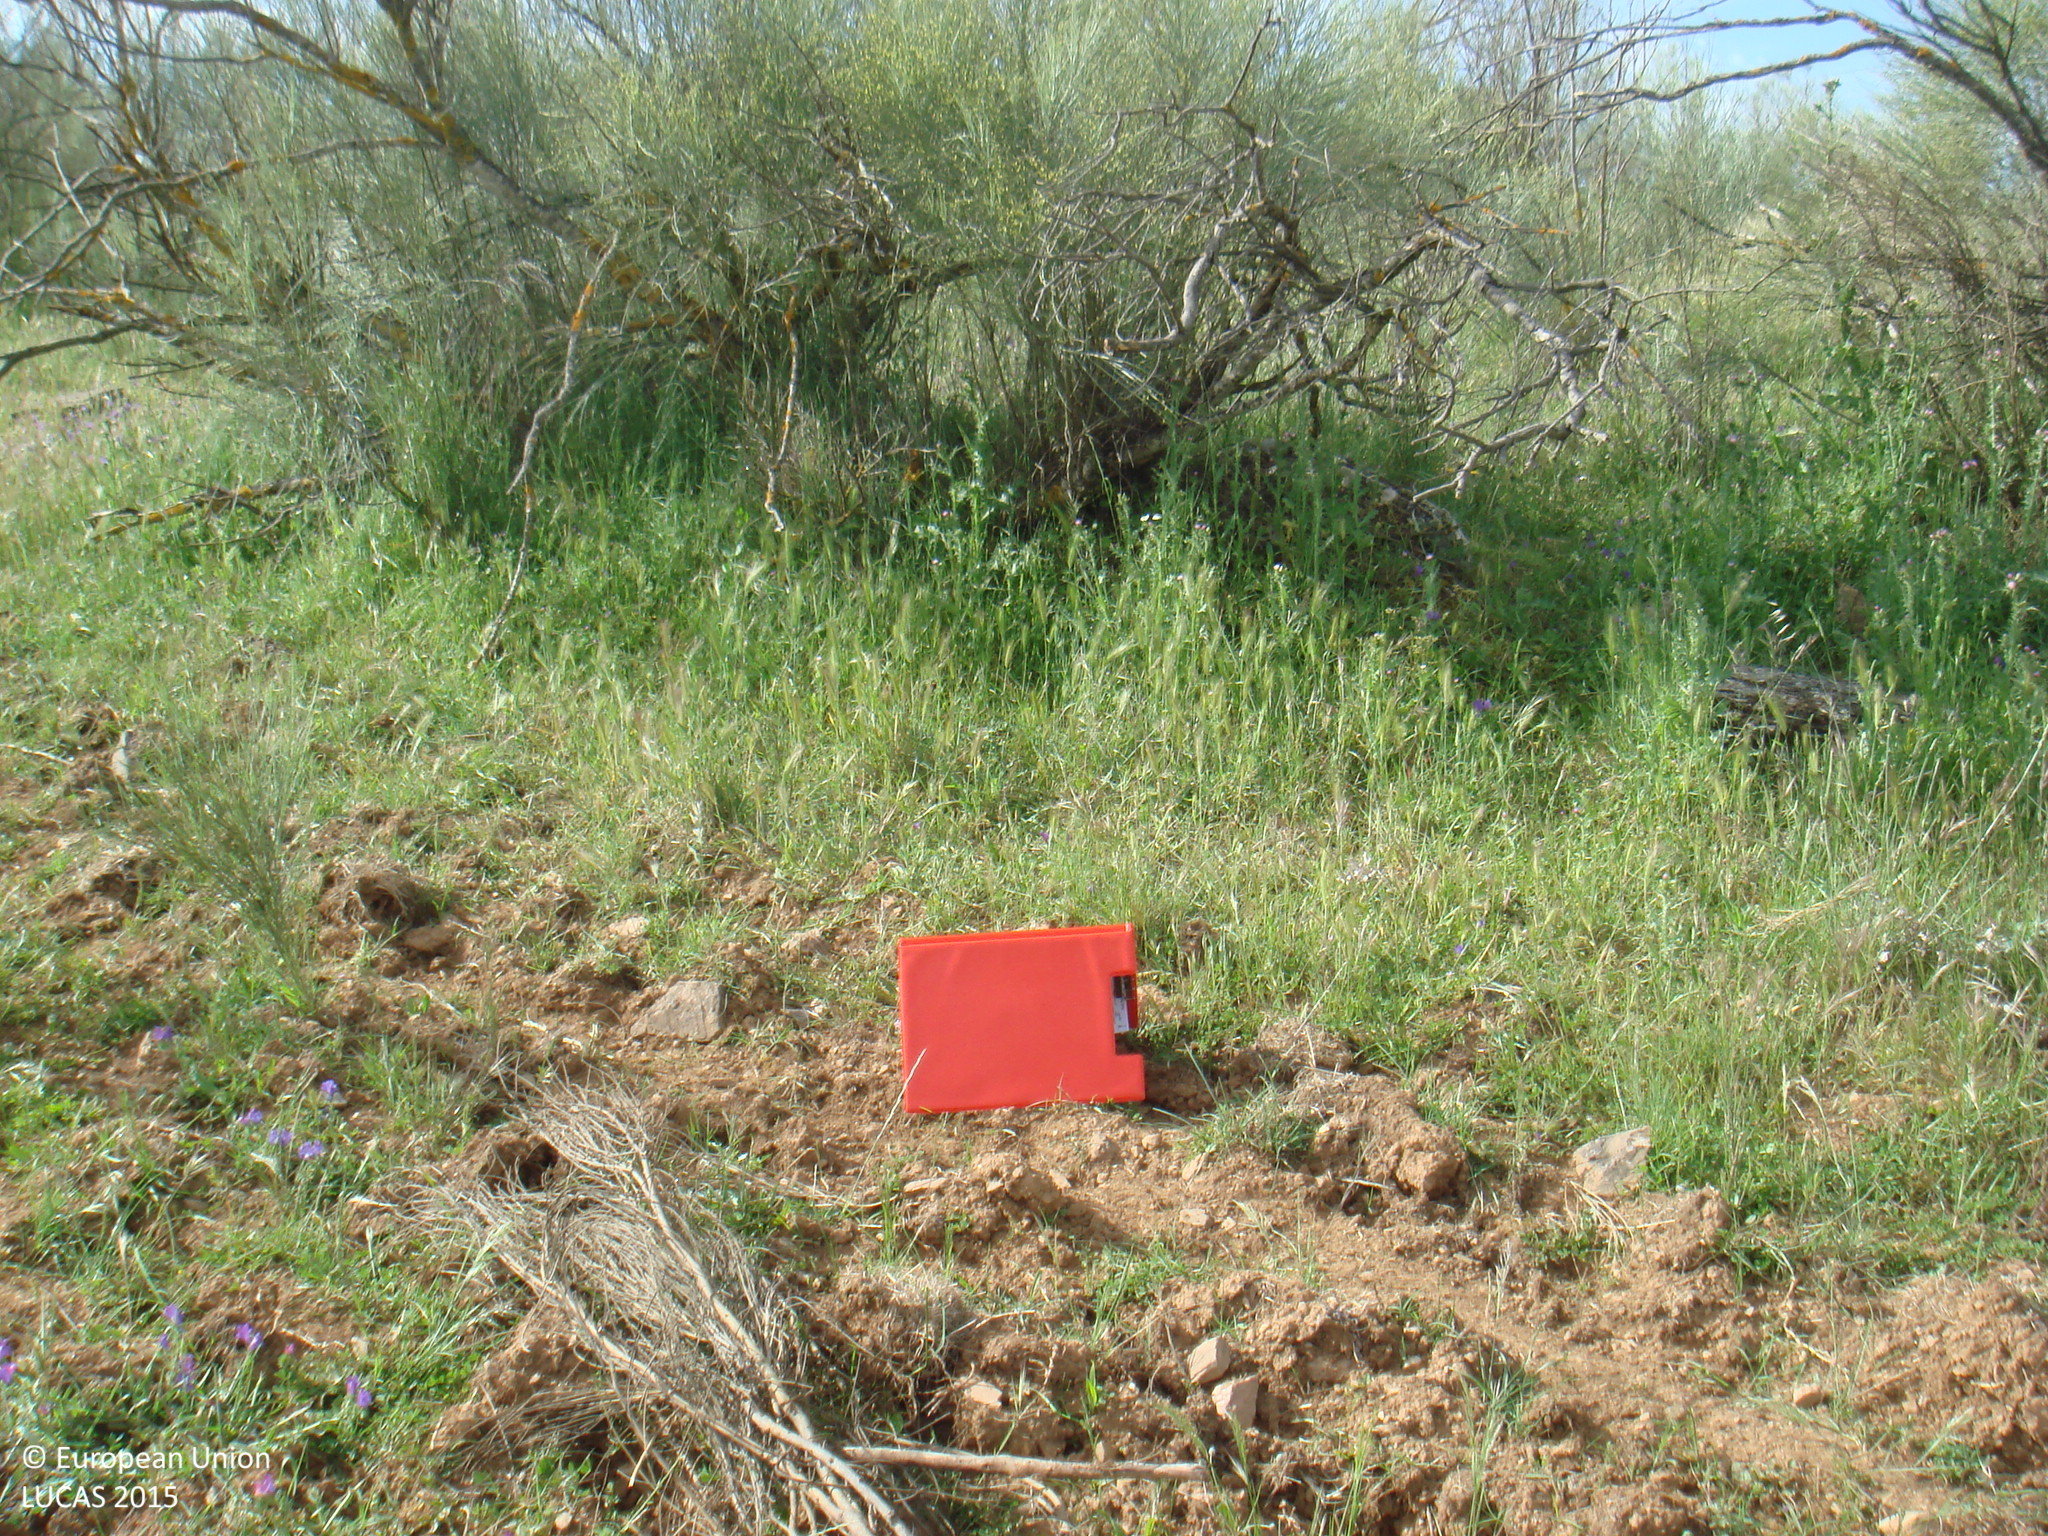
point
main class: Shrubland
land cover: Shrubland without tree cover
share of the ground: > 75 %
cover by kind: herbaceous plants 70 %, shrubs 30 %
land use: Semi-natural and natural areas not in use
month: May
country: ES
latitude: 38.4307
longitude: -5.0917
